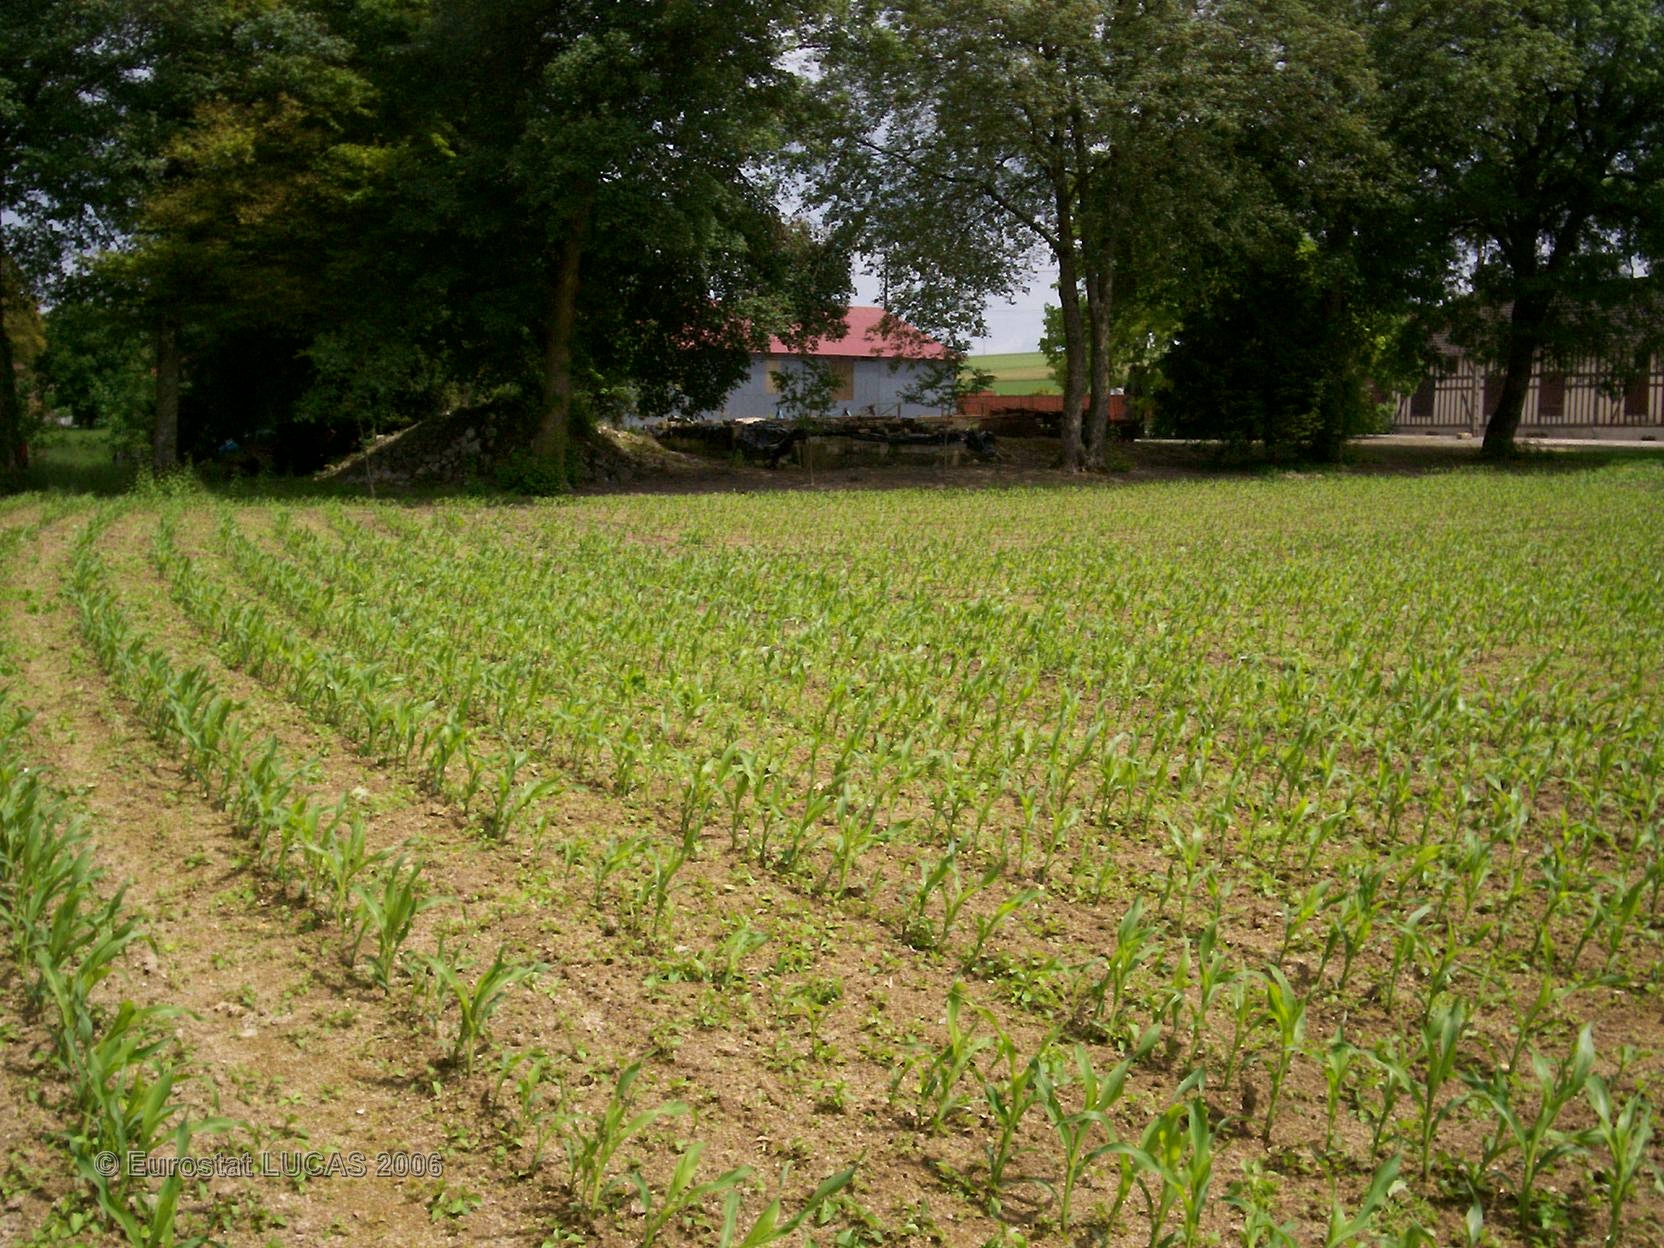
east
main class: Cropland
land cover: Maize
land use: Agriculture (excluding fallow land and kitchen gardens)
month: June
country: FR
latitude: 48.6592
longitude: 4.4169
